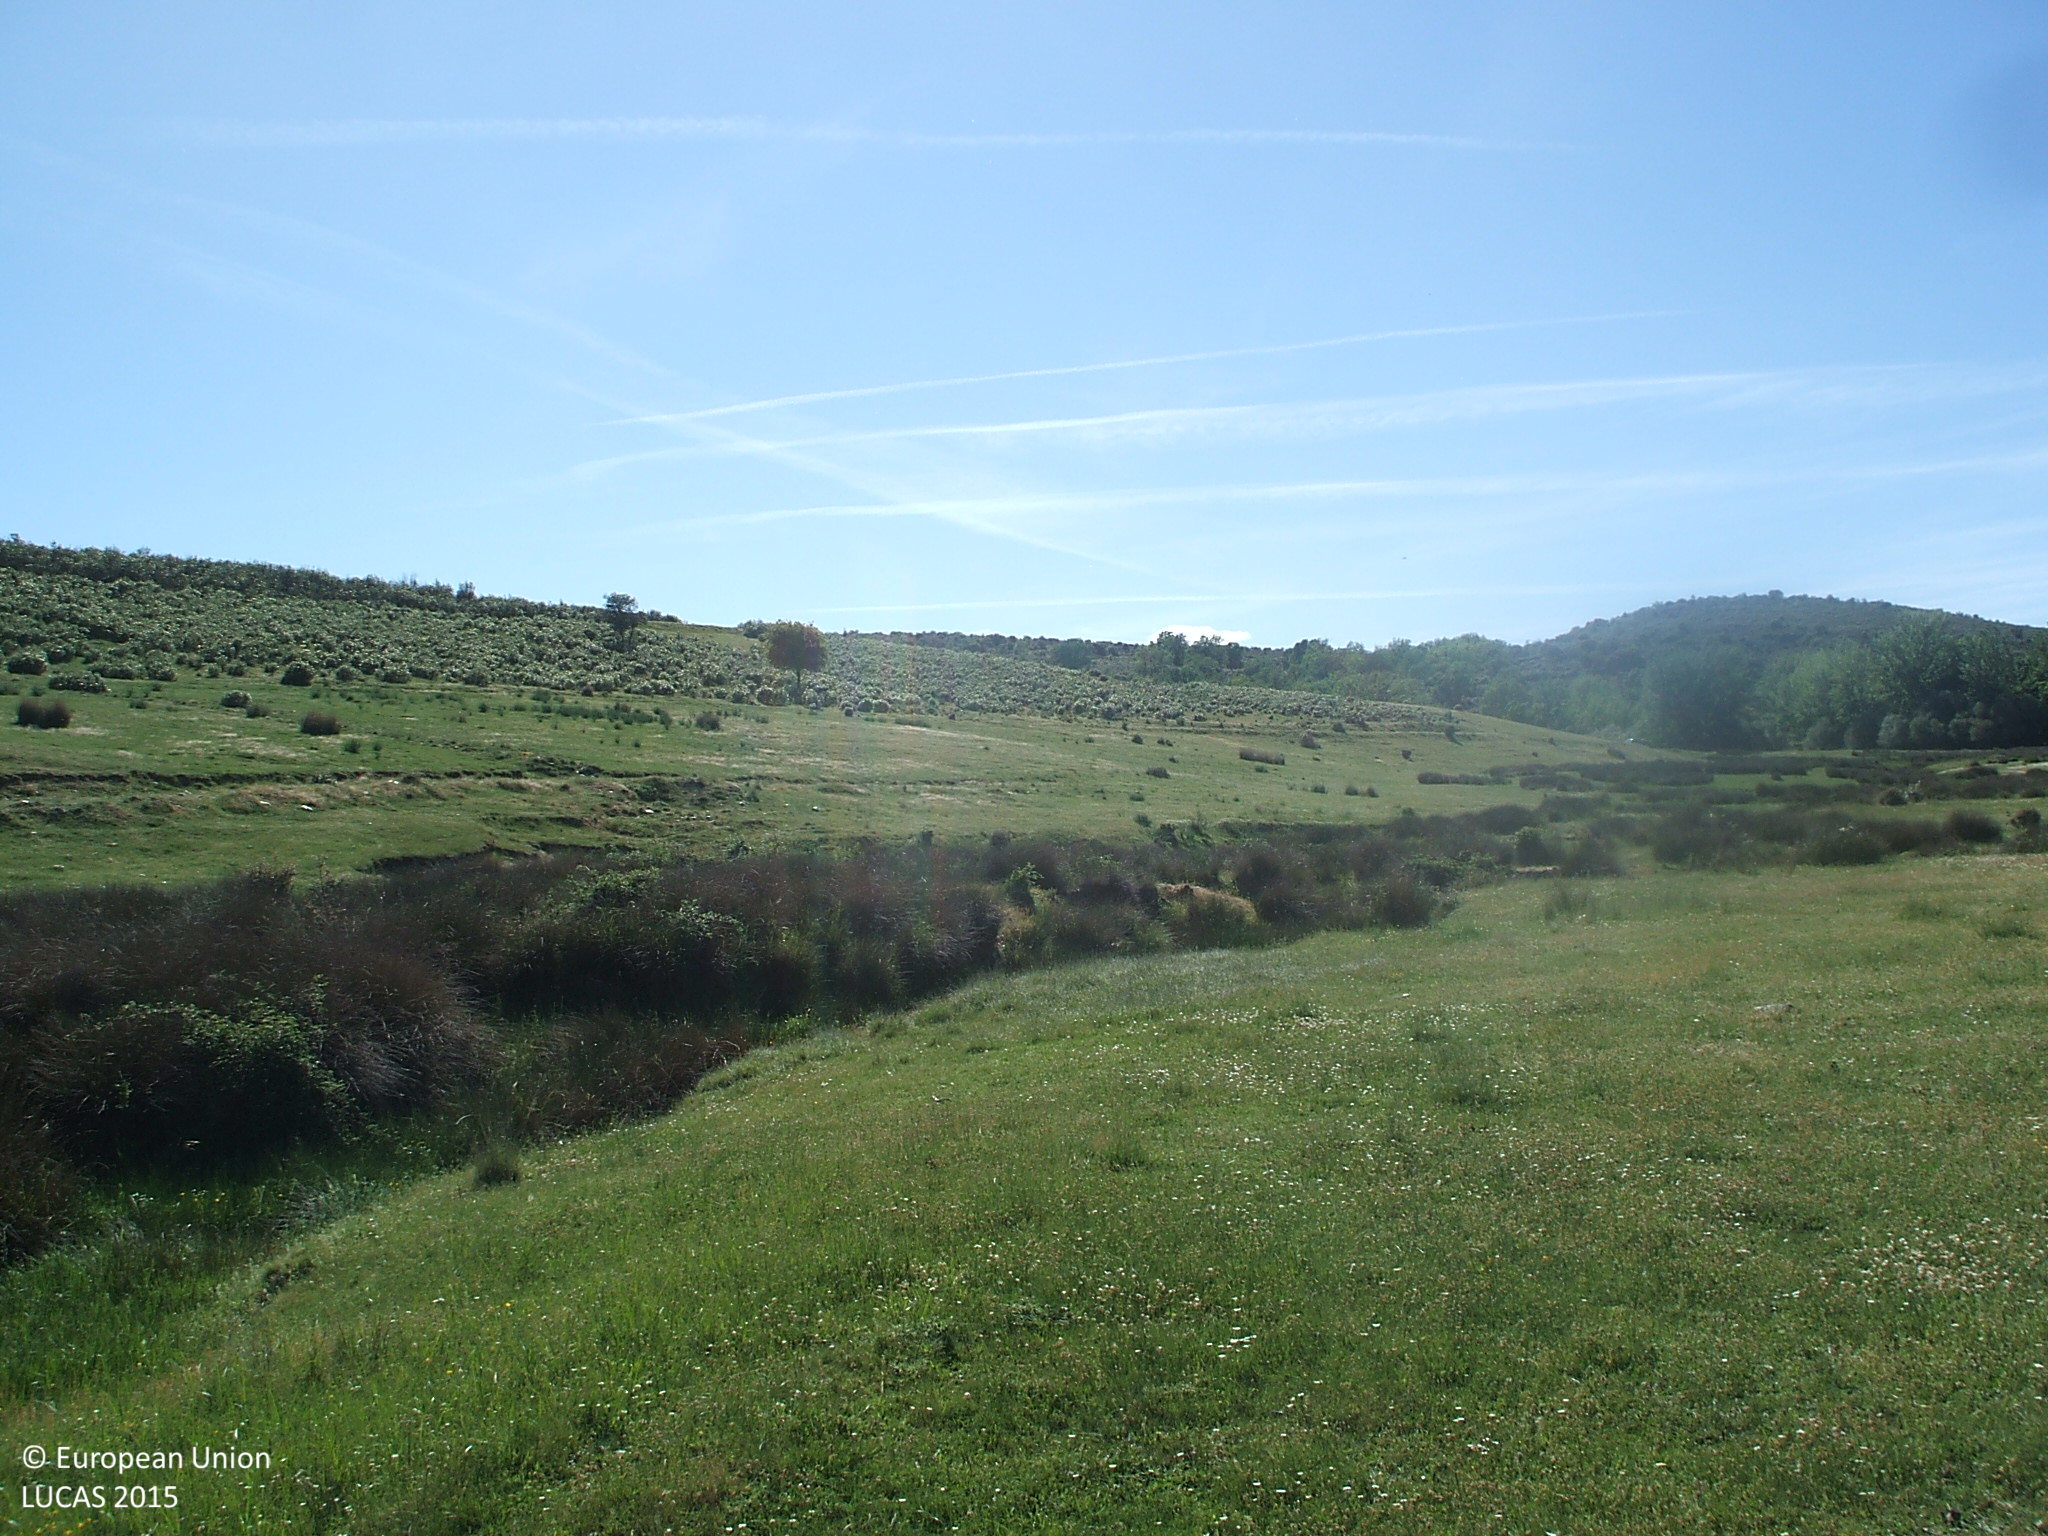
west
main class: Grassland
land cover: Grassland without tree/shrub cover
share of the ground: > 75 %
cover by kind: herbaceous plants 100 %
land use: Agriculture (excluding fallow land and kitchen gardens)
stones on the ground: > 50 %
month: May
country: ES
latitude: 41.0752
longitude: -3.0461
